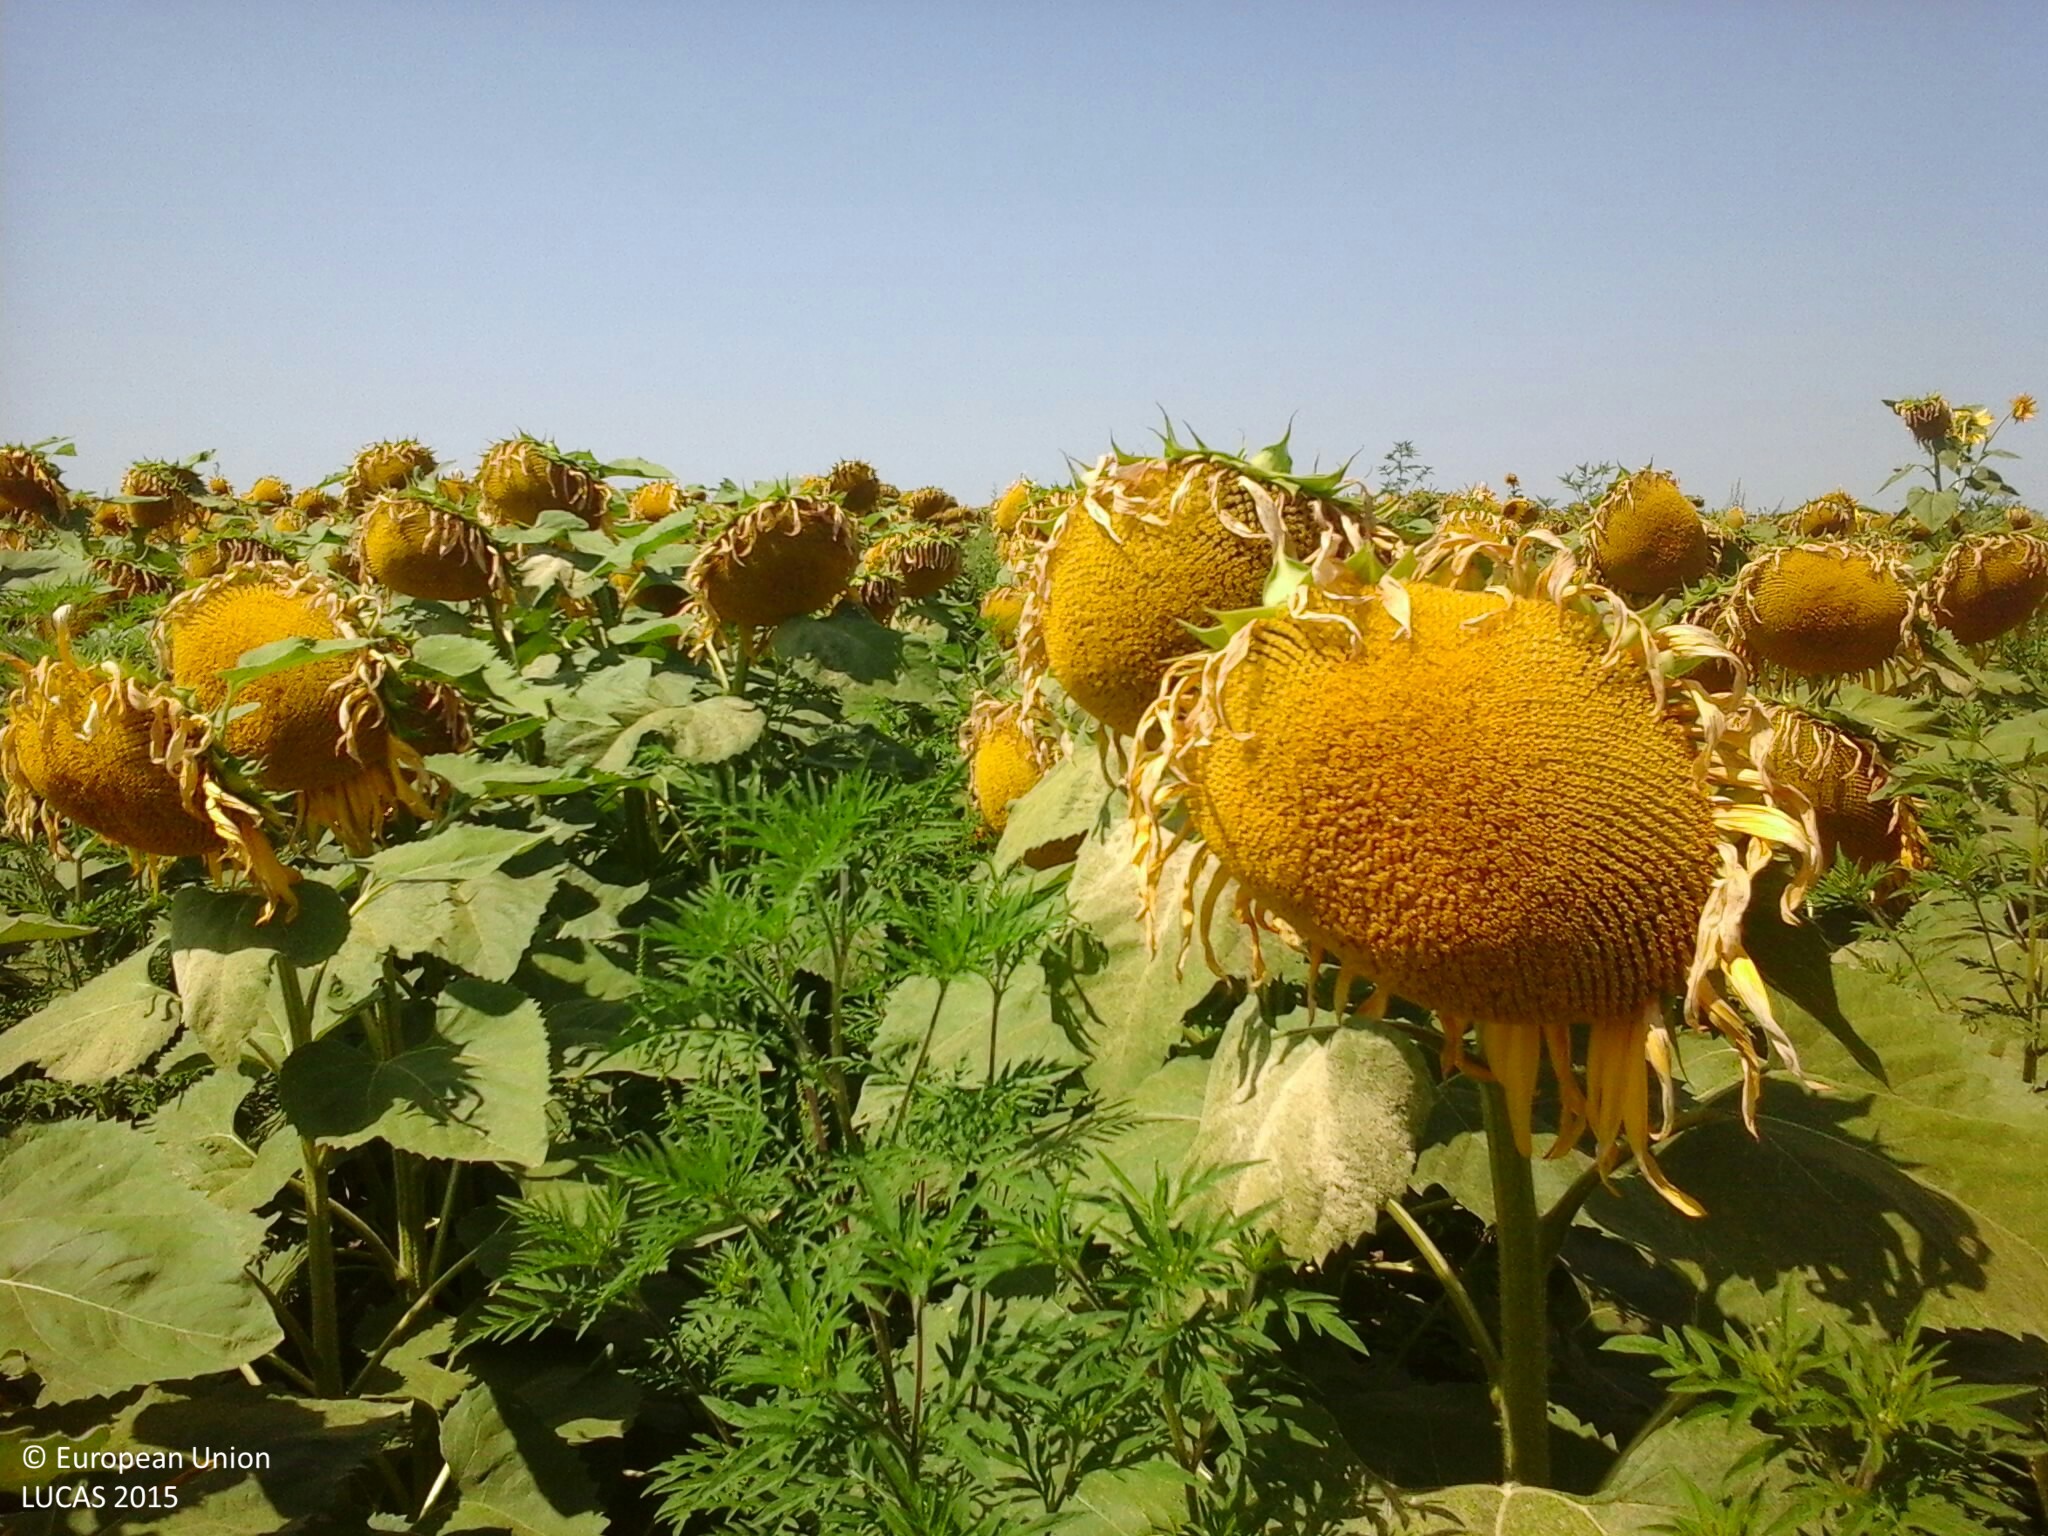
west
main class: Cropland
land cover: Sunflower
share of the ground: > 75 %
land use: Agriculture (excluding fallow land and kitchen gardens)
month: July
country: HU
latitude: 47.1181
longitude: 18.2486
